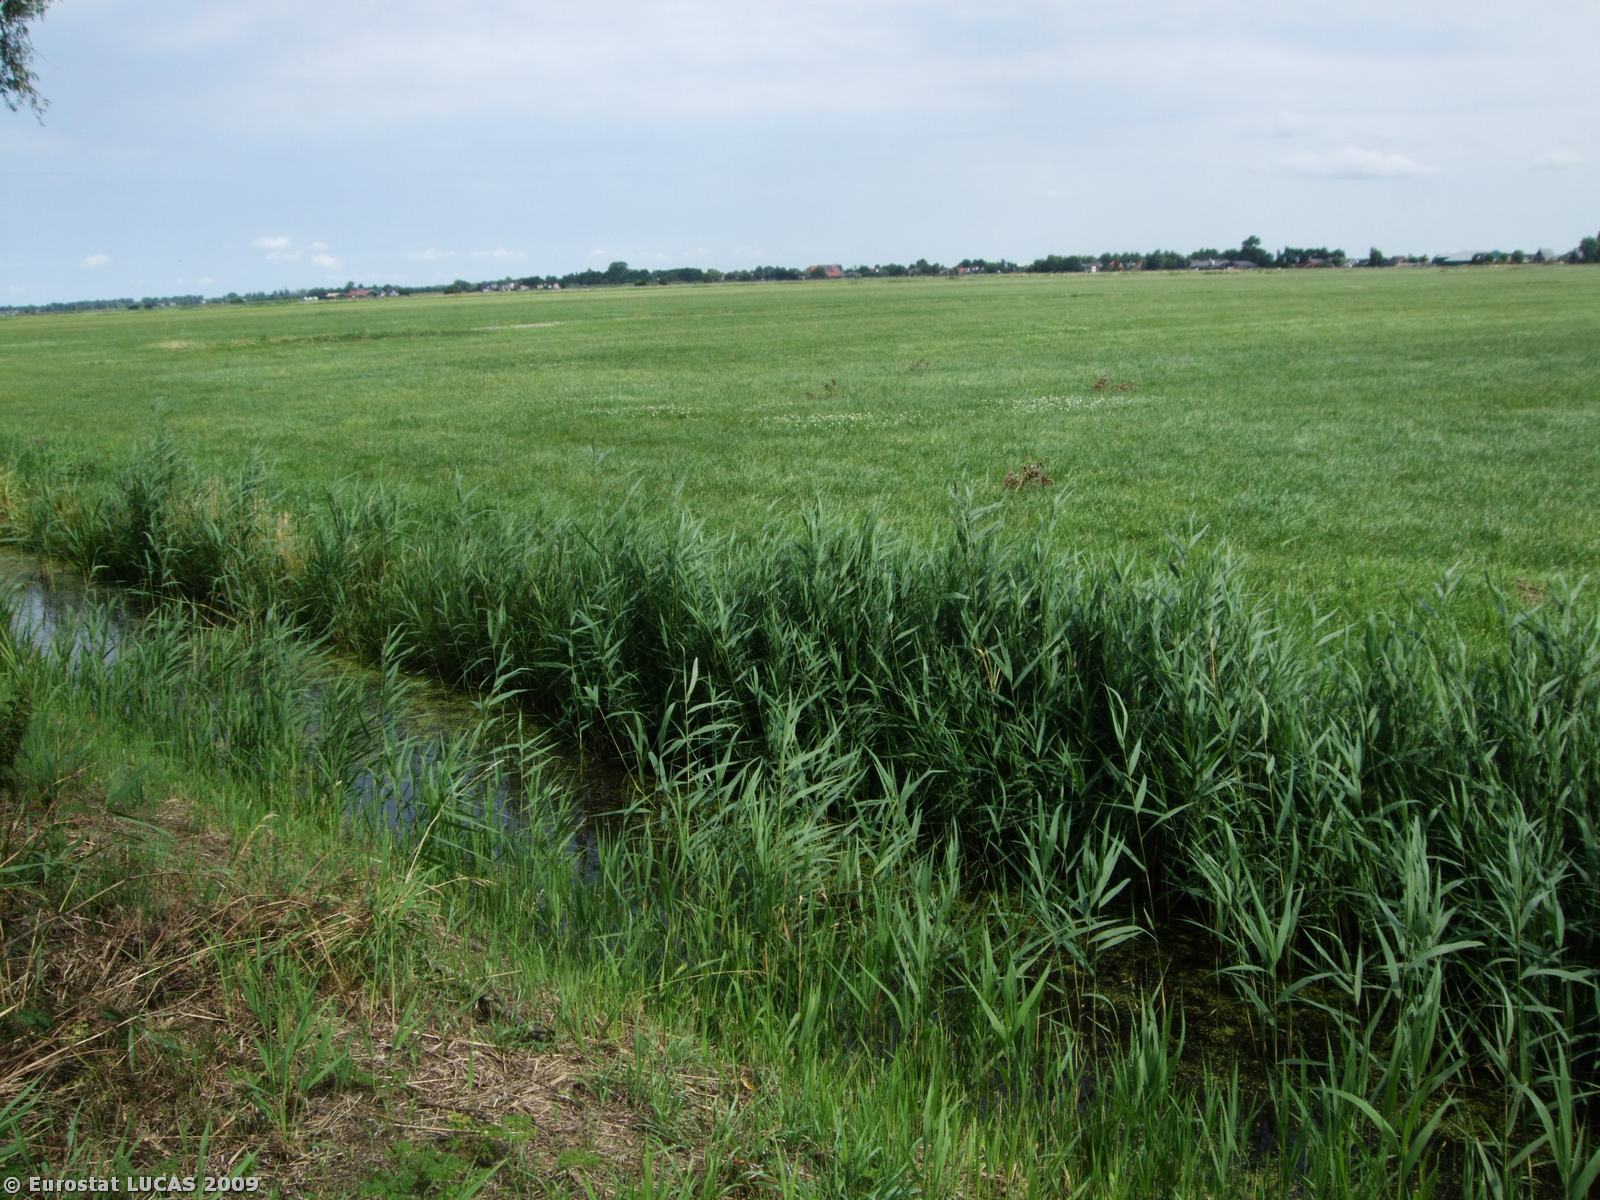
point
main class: Woodland
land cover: Broadleaved woodland
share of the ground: 50 - 75 %
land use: Road transport
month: July
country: NL
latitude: 52.9813
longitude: 5.6349
